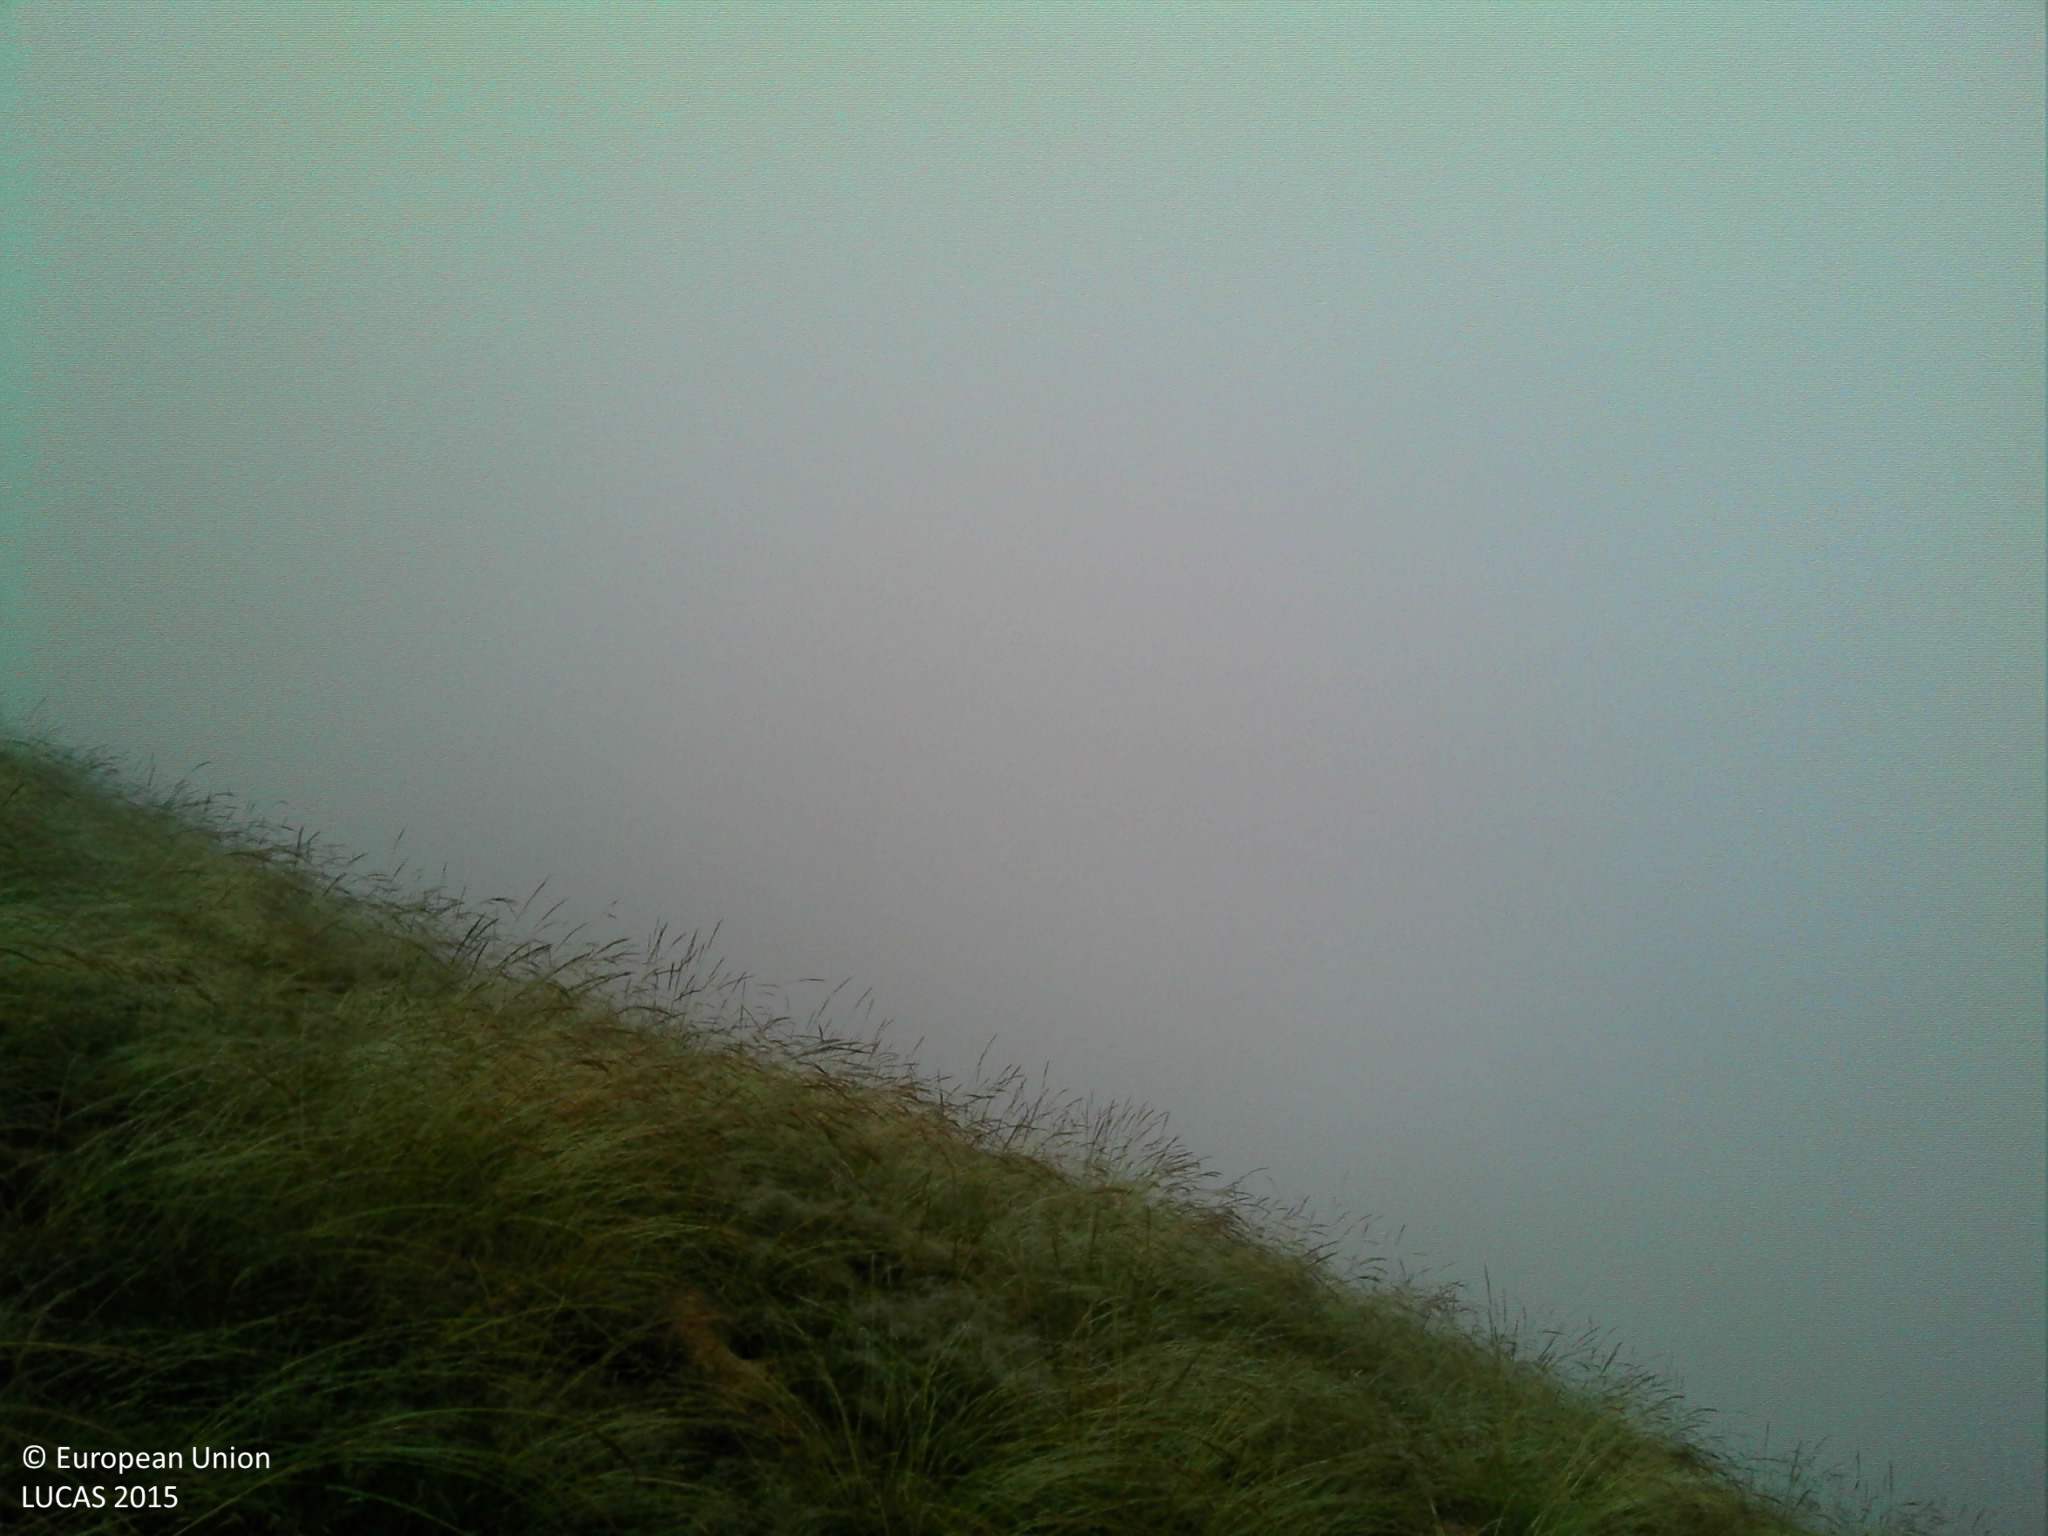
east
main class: Grassland
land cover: Grassland without tree/shrub cover
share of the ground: > 75 %
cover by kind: herbaceous plants 100 %
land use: Agriculture (excluding fallow land and kitchen gardens)
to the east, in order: Grassland without tree/shrub cover; Spontaneously vegetated surfaces; Tracks; Spontaneously vegetated surfaces
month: July
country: FR
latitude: 42.7918
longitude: 1.1425
